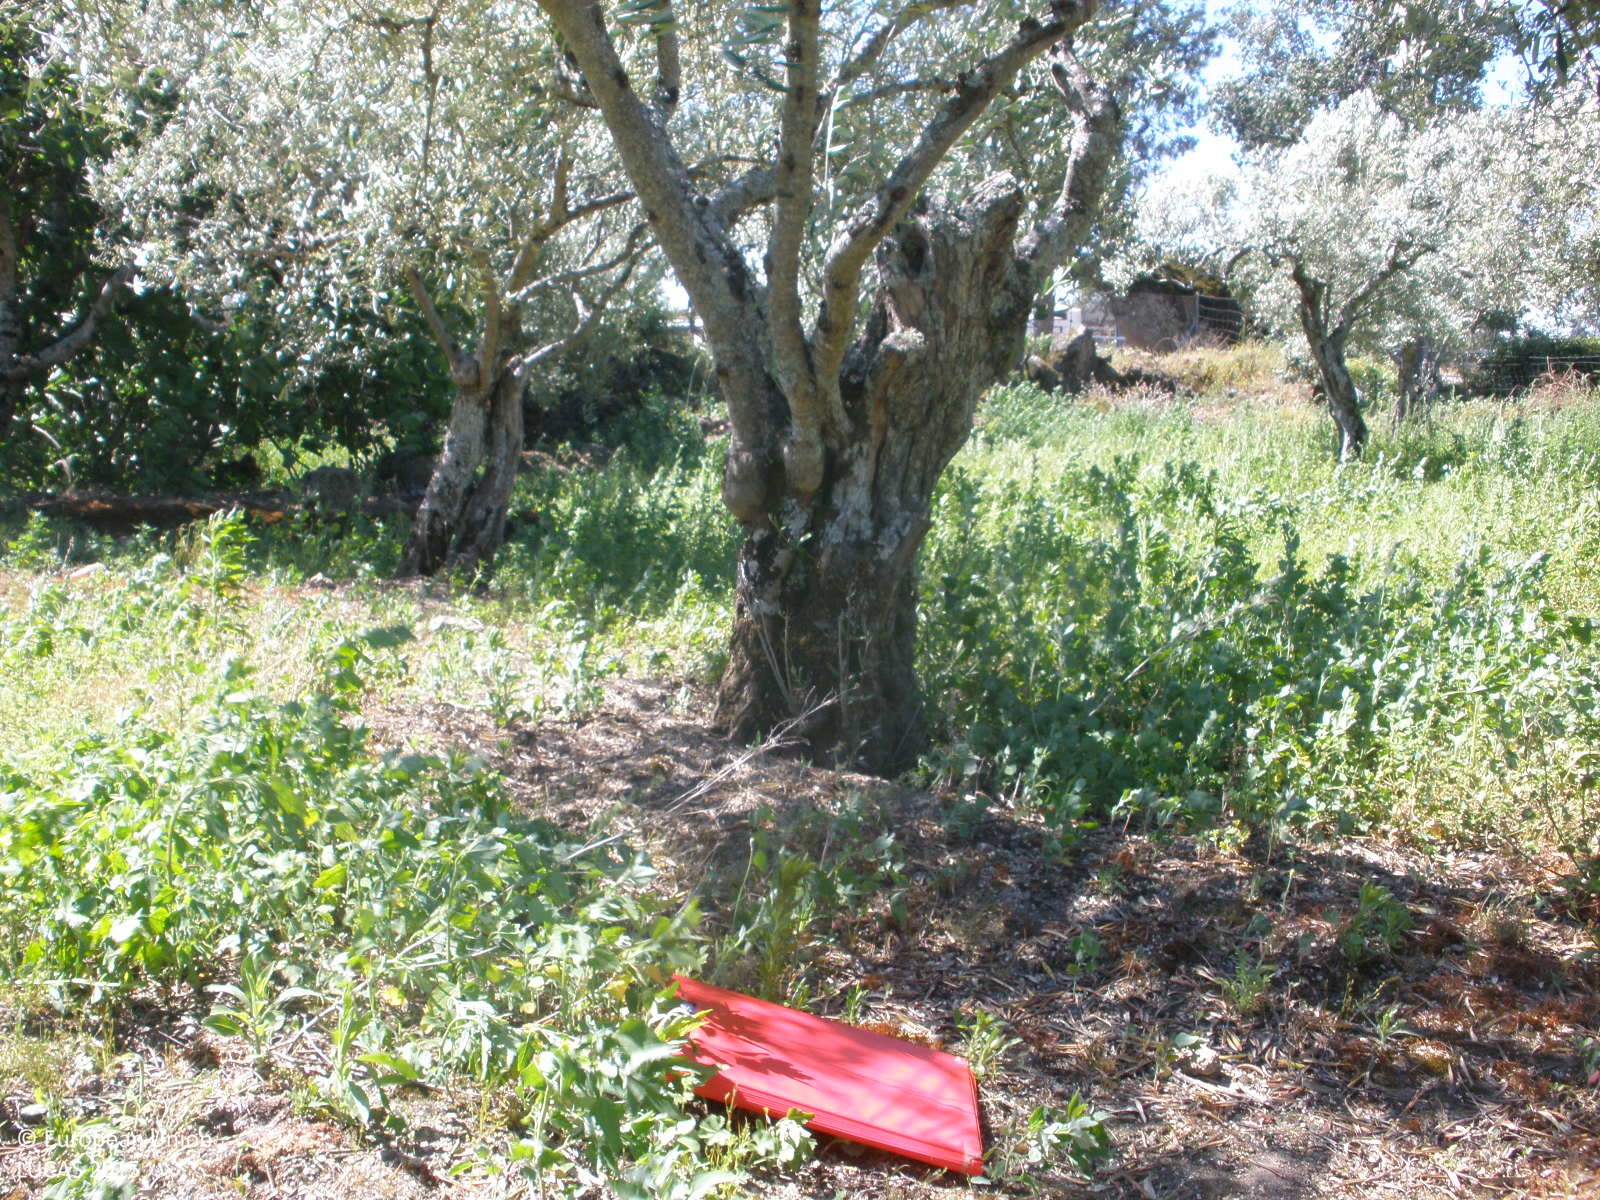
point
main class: Cropland
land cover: Olive groves
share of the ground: 50 - 75 %
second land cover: Spontaneously vegetated surfaces
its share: > 75 %
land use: Agriculture (excluding fallow land and kitchen gardens)
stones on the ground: < 10 %
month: May
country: ES
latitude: 40.2159
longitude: -6.8586
